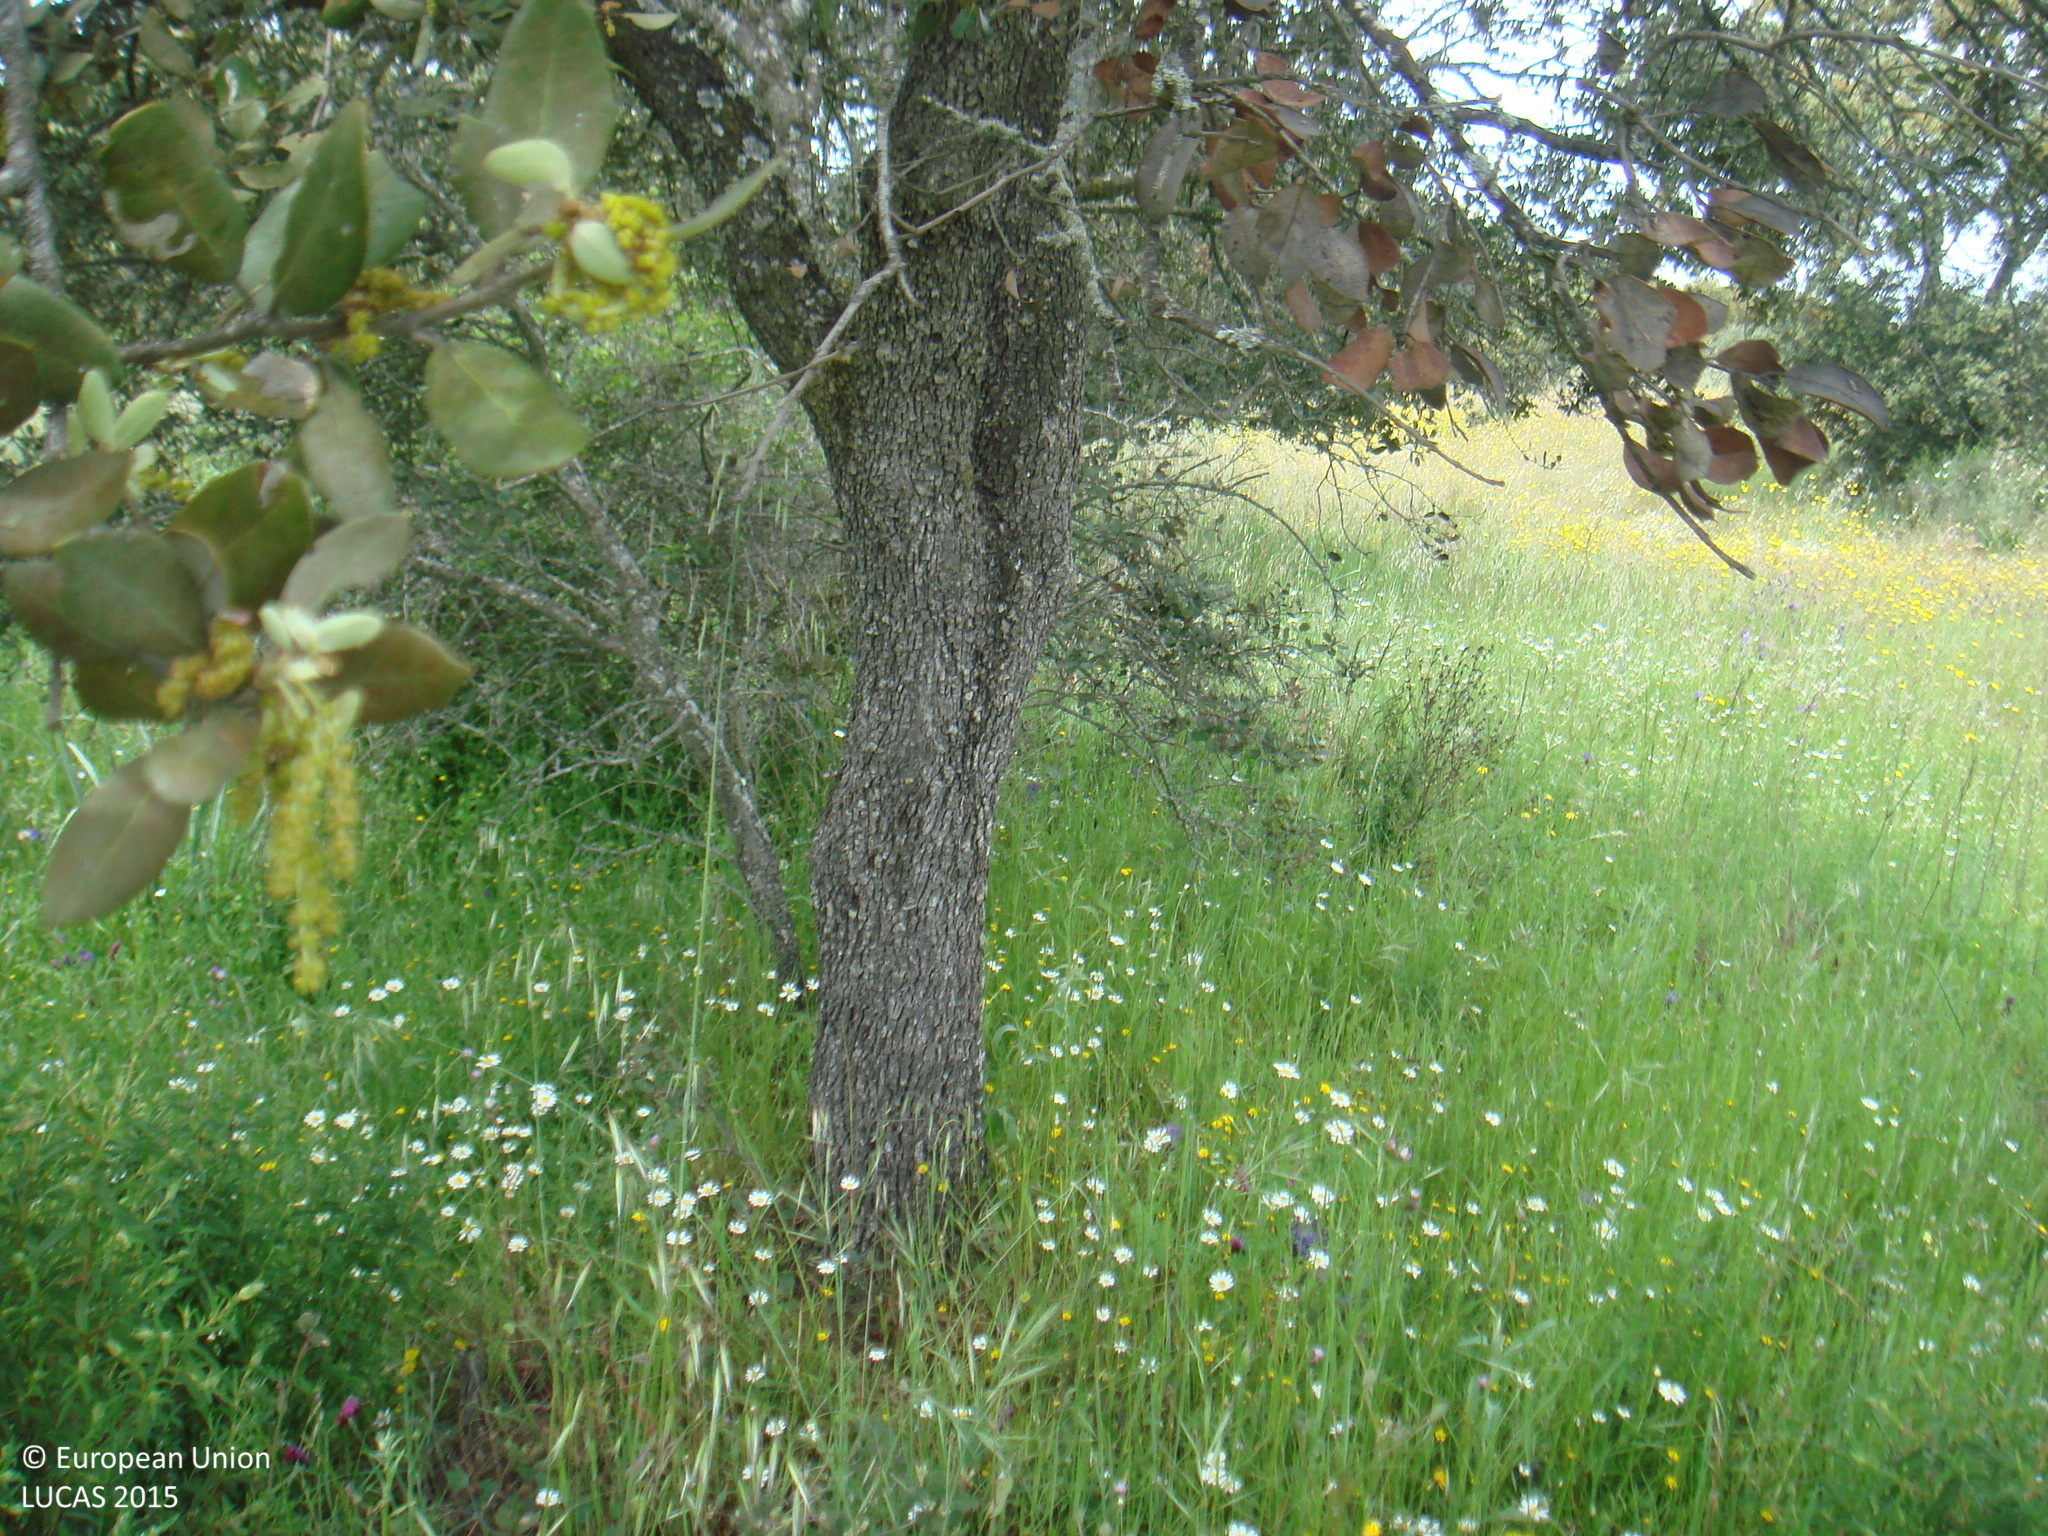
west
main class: Woodland
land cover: Broadleaved woodland
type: broadleaved evergreen forest
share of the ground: 10 - 25 %
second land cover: Grassland without tree/shrub cover
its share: > 75 %
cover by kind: herbaceous plants 80 %, broadleaved forest trees 15 %, shrubs 5 %
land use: Forestry
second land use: Agriculture (excluding fallow land and kitchen gardens)
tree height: > 5 m
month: May
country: ES
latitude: 38.3420
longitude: -5.0715
